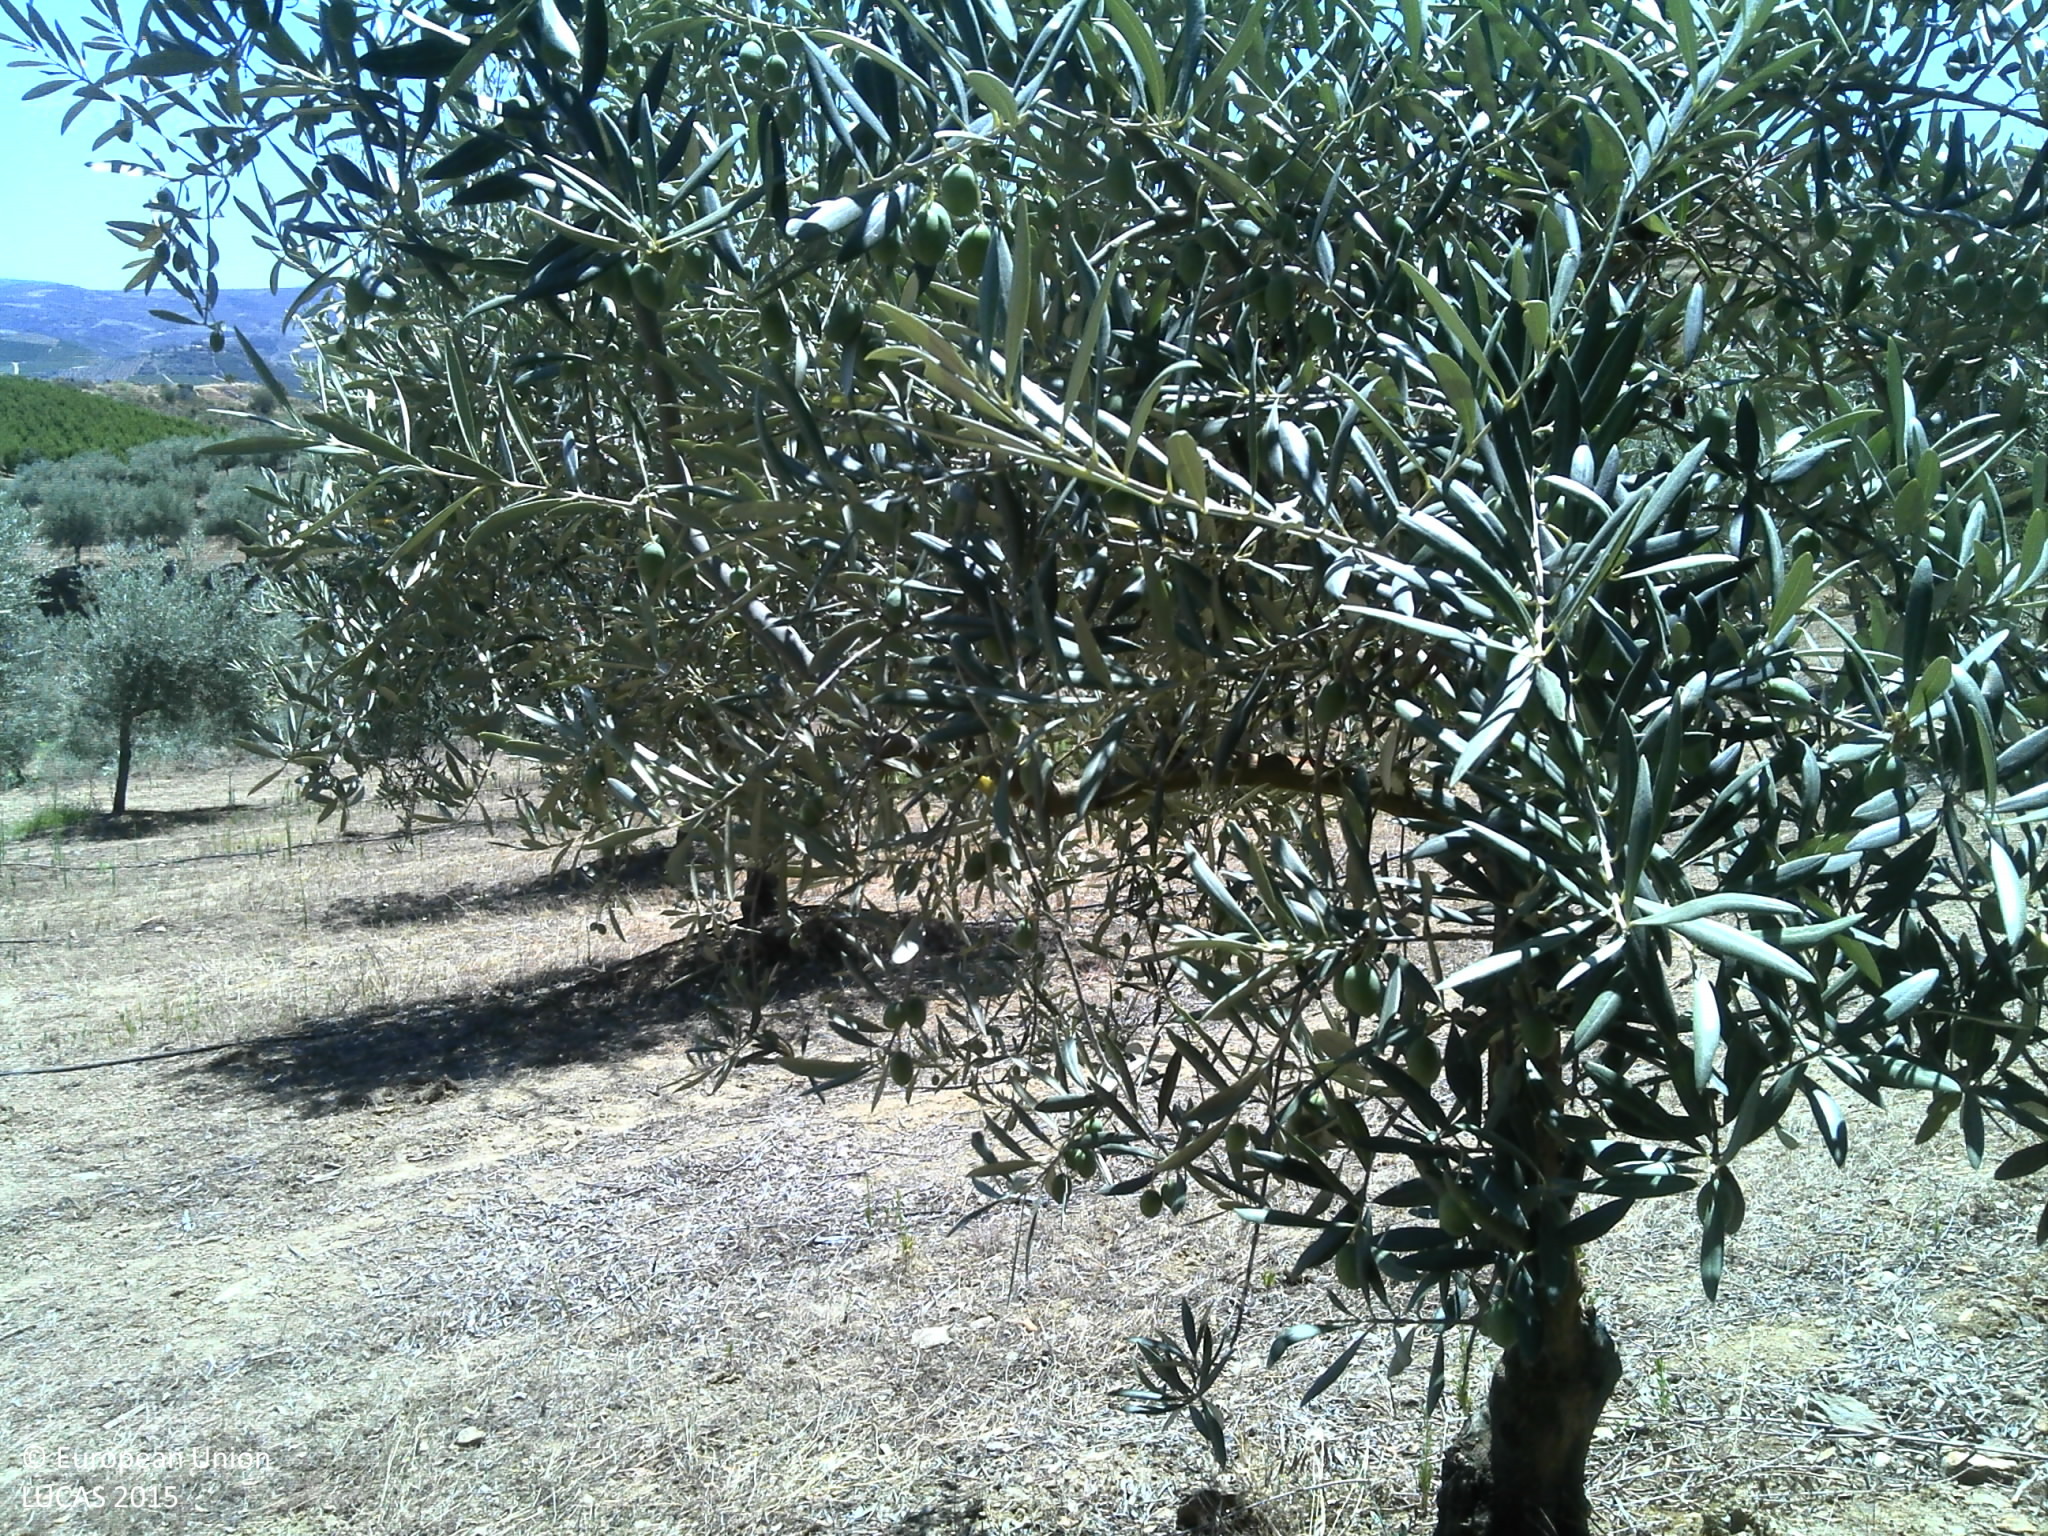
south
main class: Cropland
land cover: Olive groves
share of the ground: 10 - 25 %
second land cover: Spontaneously vegetated surfaces
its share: 25 - 50 %
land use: Agriculture (excluding fallow land and kitchen gardens)
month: July
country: PT
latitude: 41.3571
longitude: -7.0759
